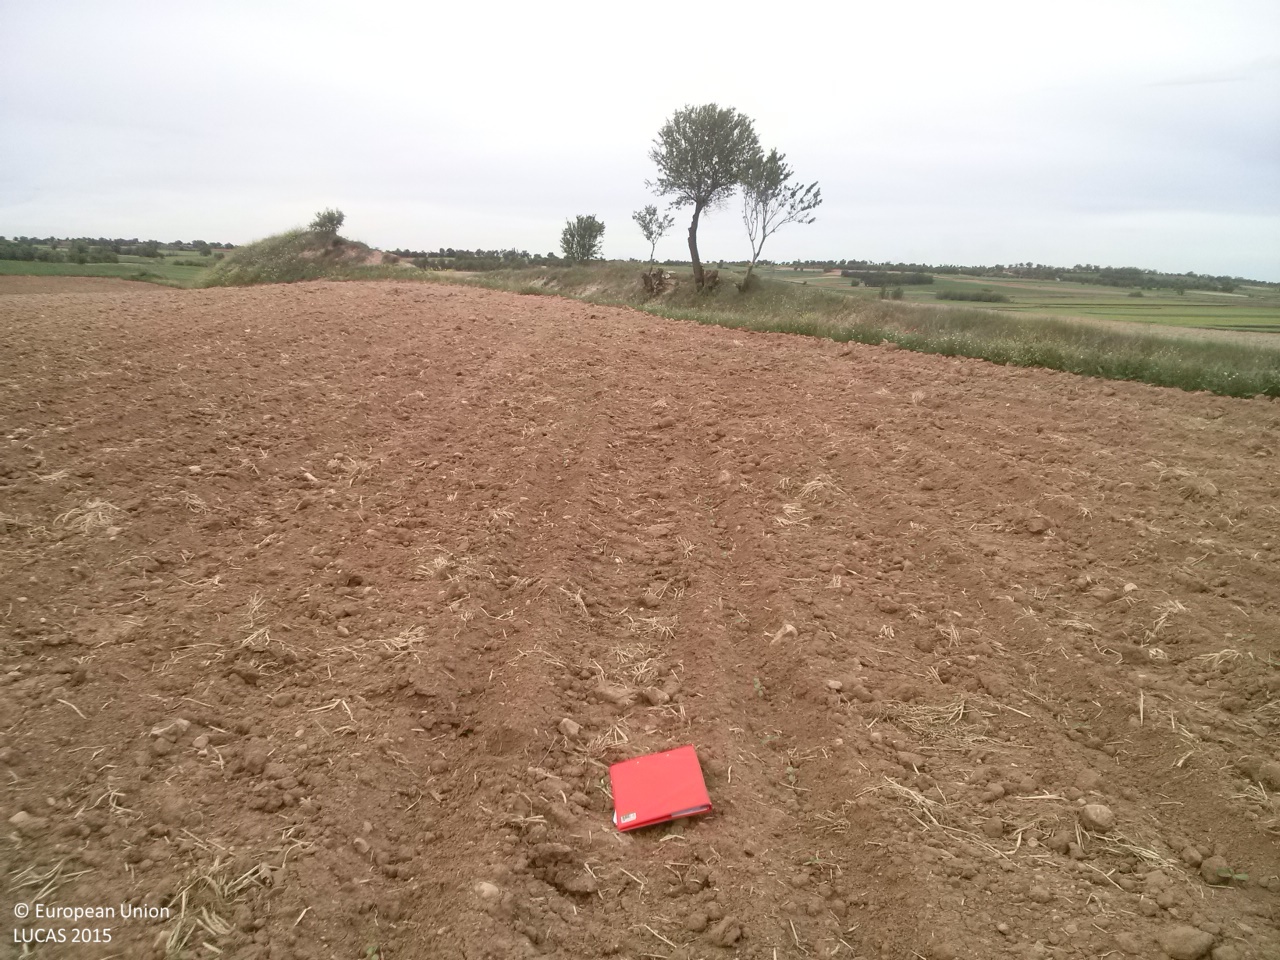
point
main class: Cropland
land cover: Sunflower
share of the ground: < 10 %
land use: Agriculture (excluding fallow land and kitchen gardens)
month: May
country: ES
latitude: 39.9089
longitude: -2.8769
